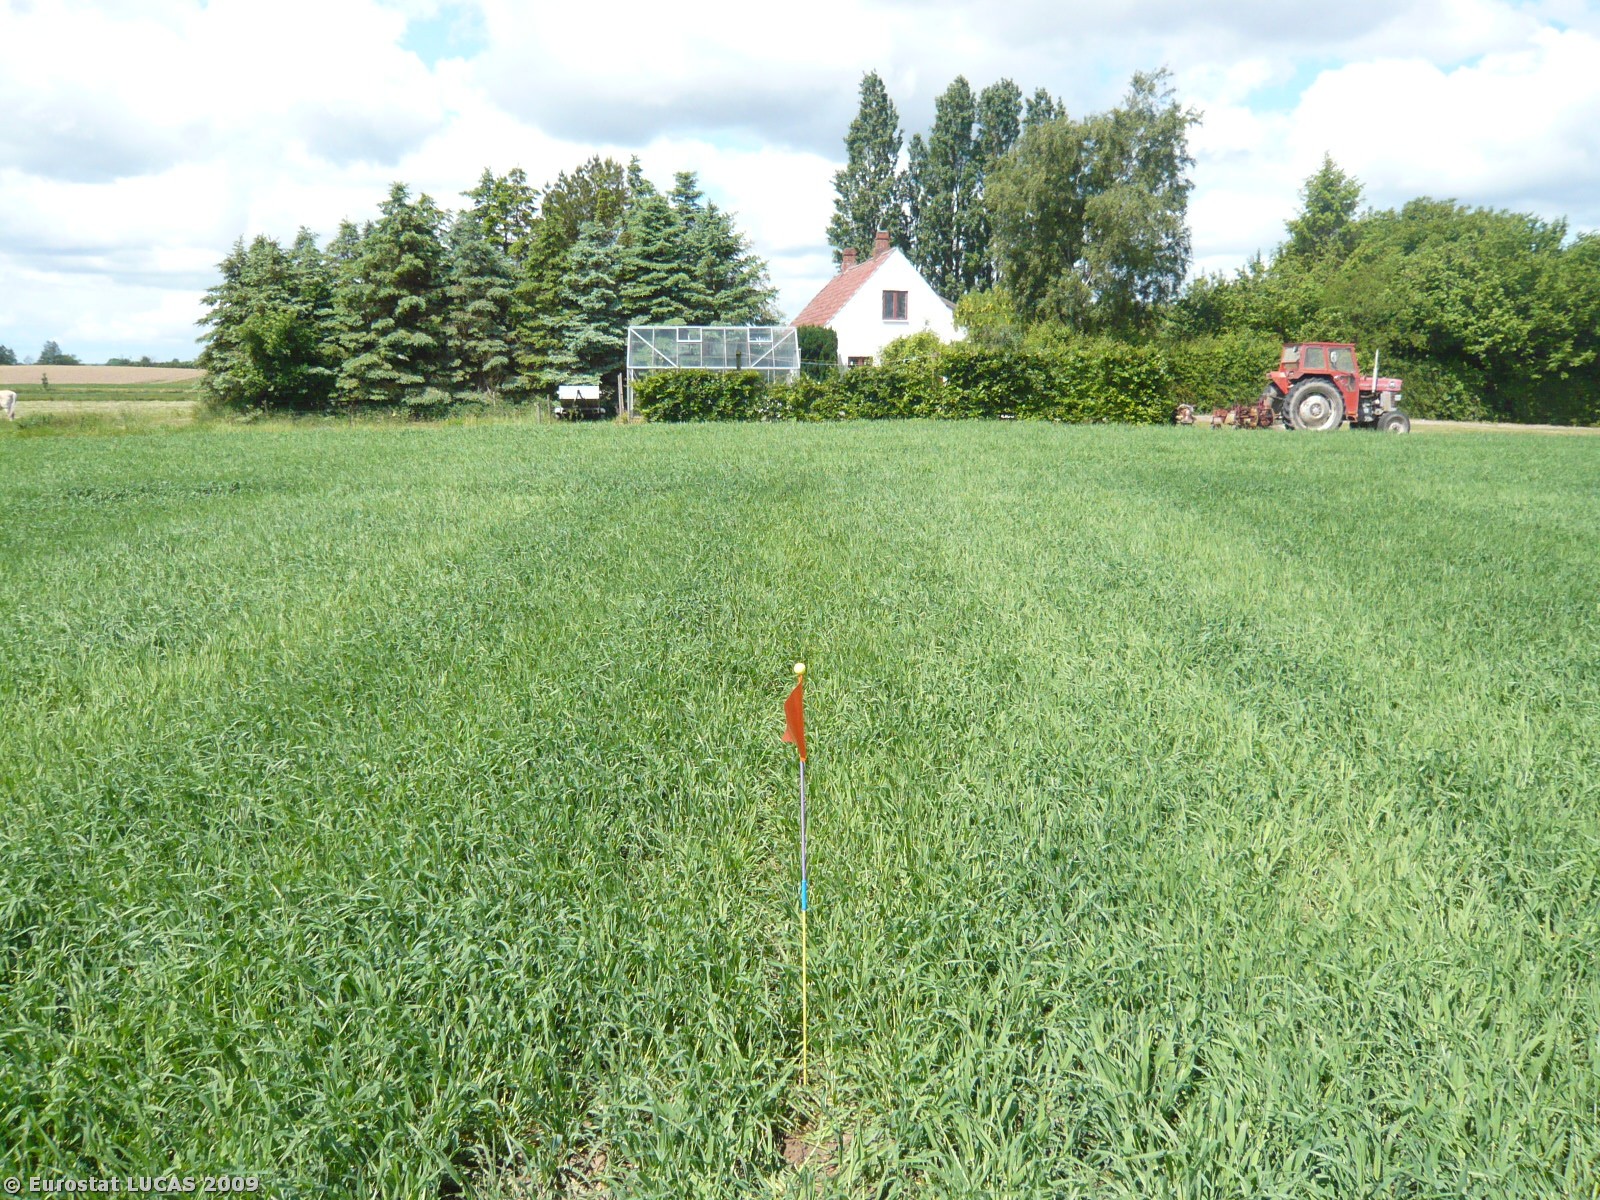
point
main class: Cropland
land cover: Barley
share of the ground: > 75 %
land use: Agriculture (excluding fallow land and kitchen gardens)
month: June
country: DK
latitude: 55.2071
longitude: 11.5859
